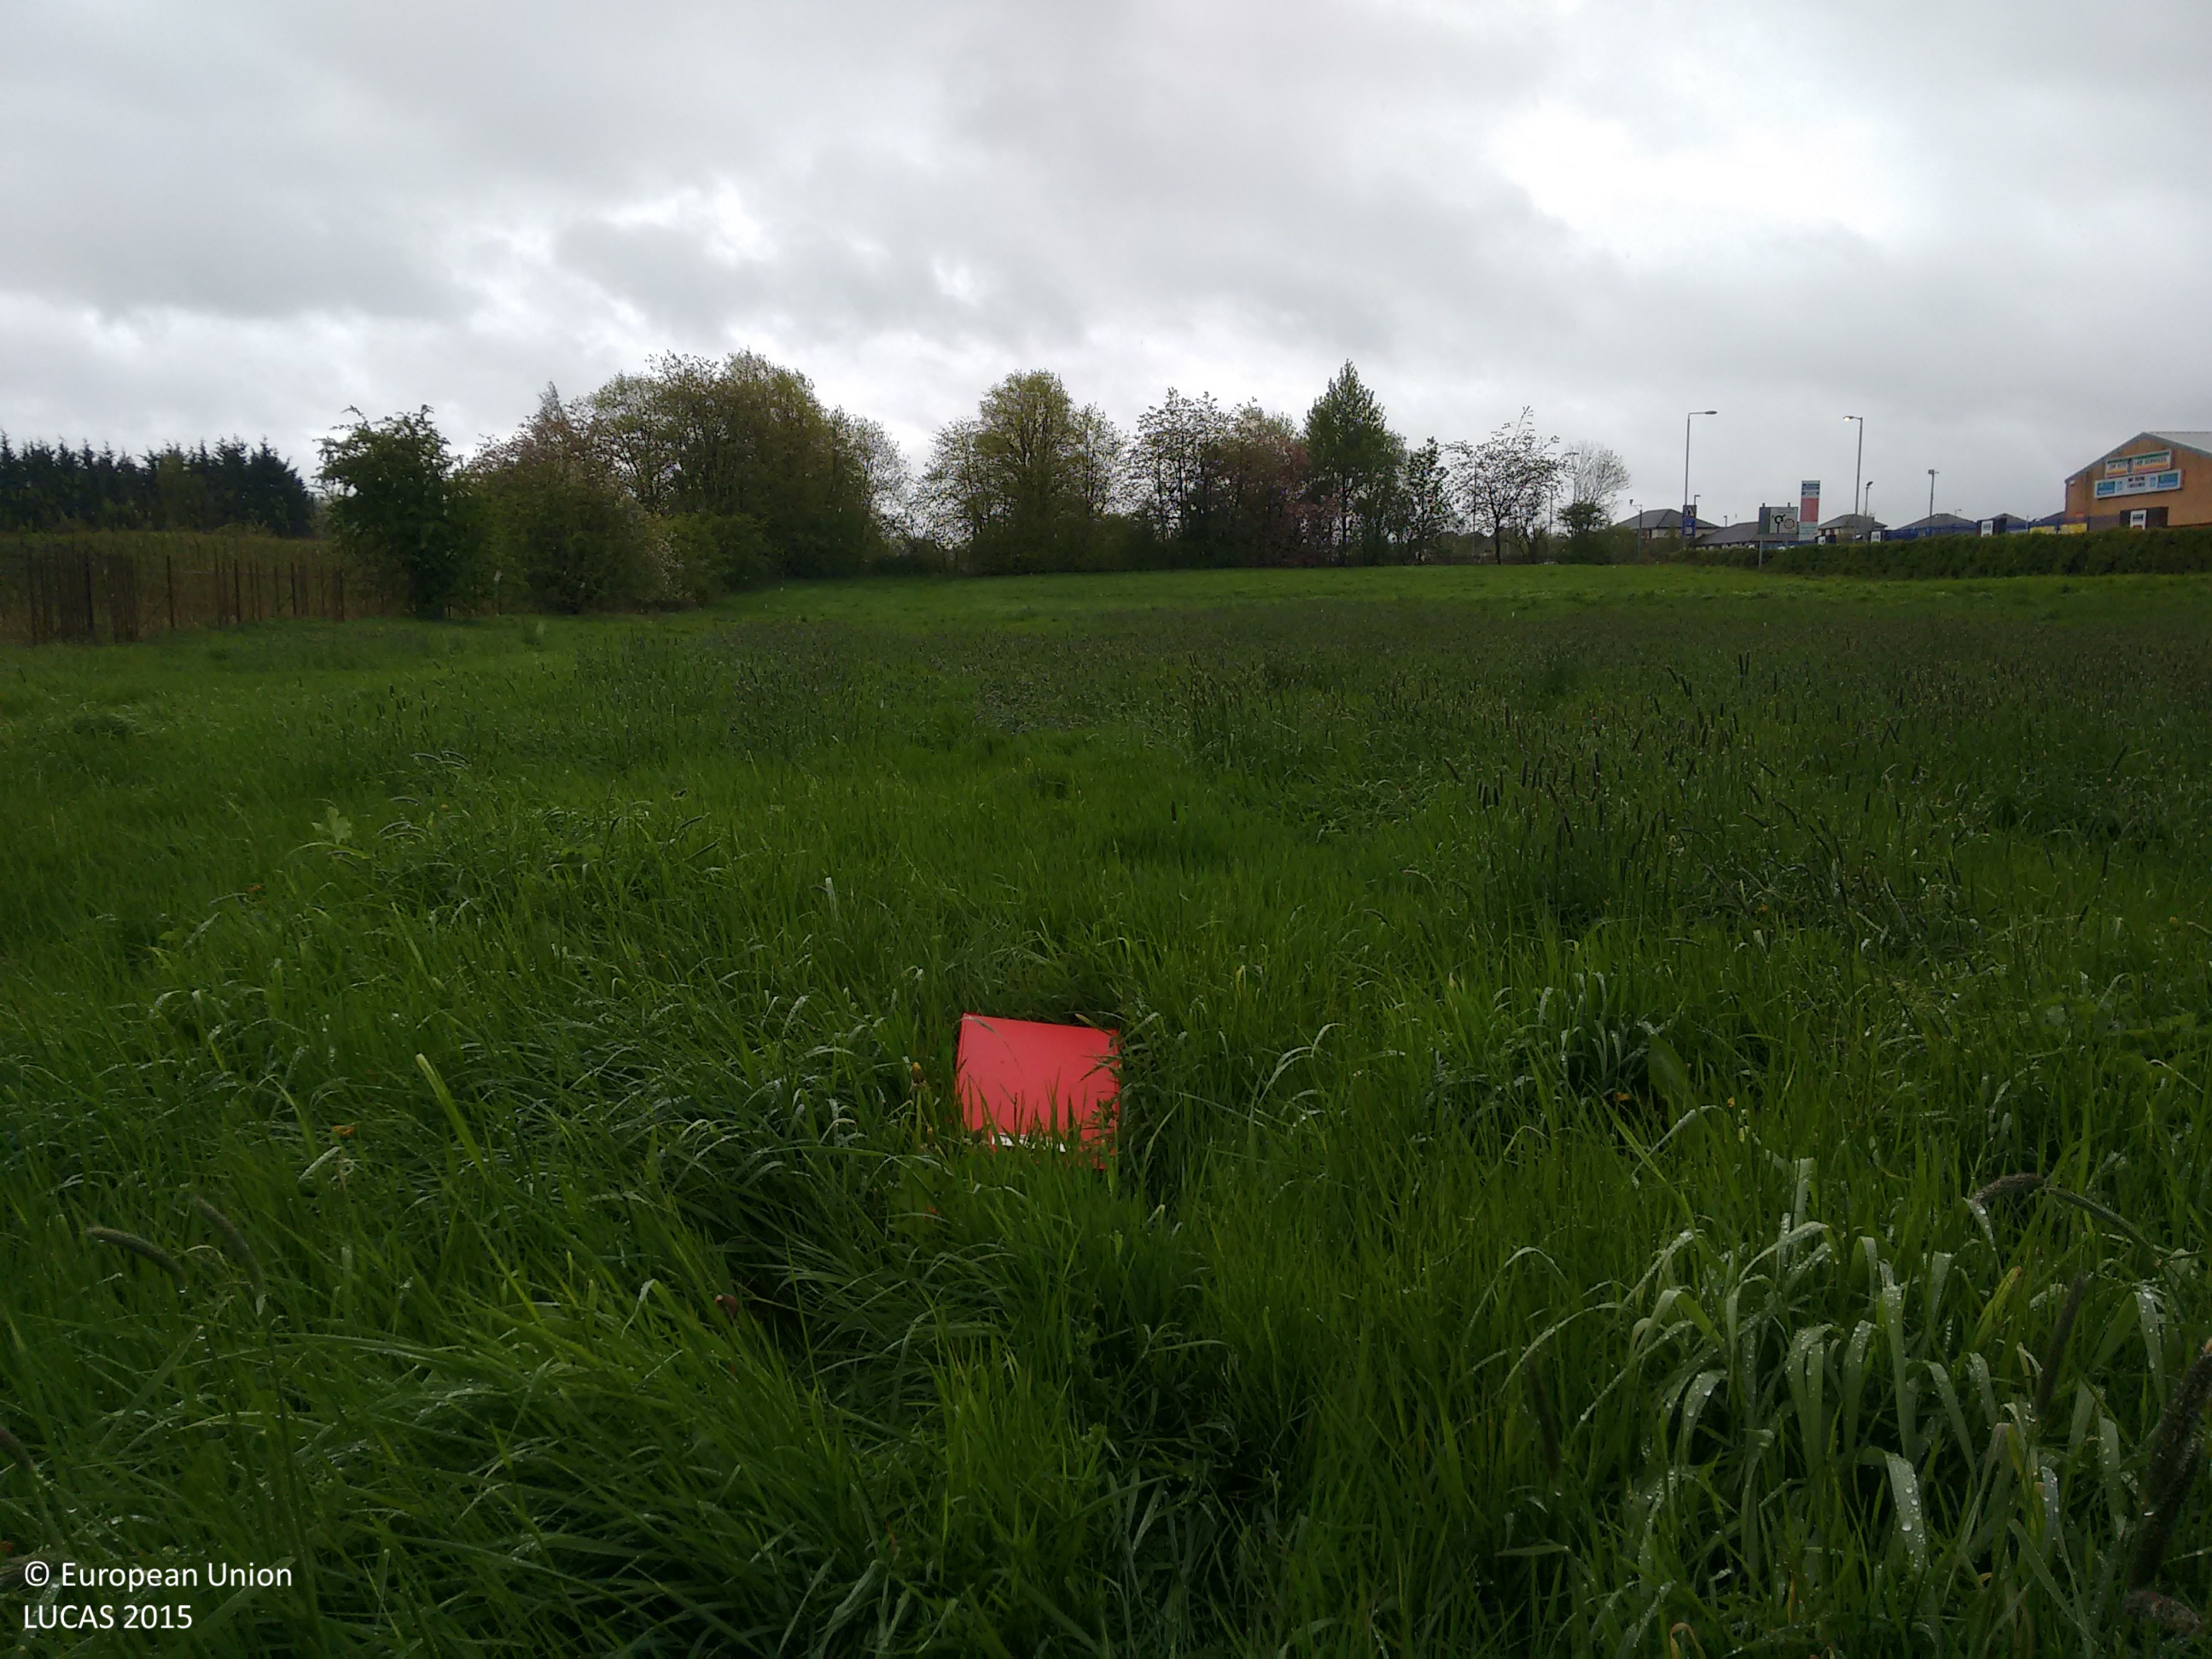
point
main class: Grassland
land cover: Grassland without tree/shrub cover
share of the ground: > 75 %
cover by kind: herbaceous plants 100 %
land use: Agriculture (excluding fallow land and kitchen gardens)
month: May
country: GB
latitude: 55.8112
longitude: -4.3776
